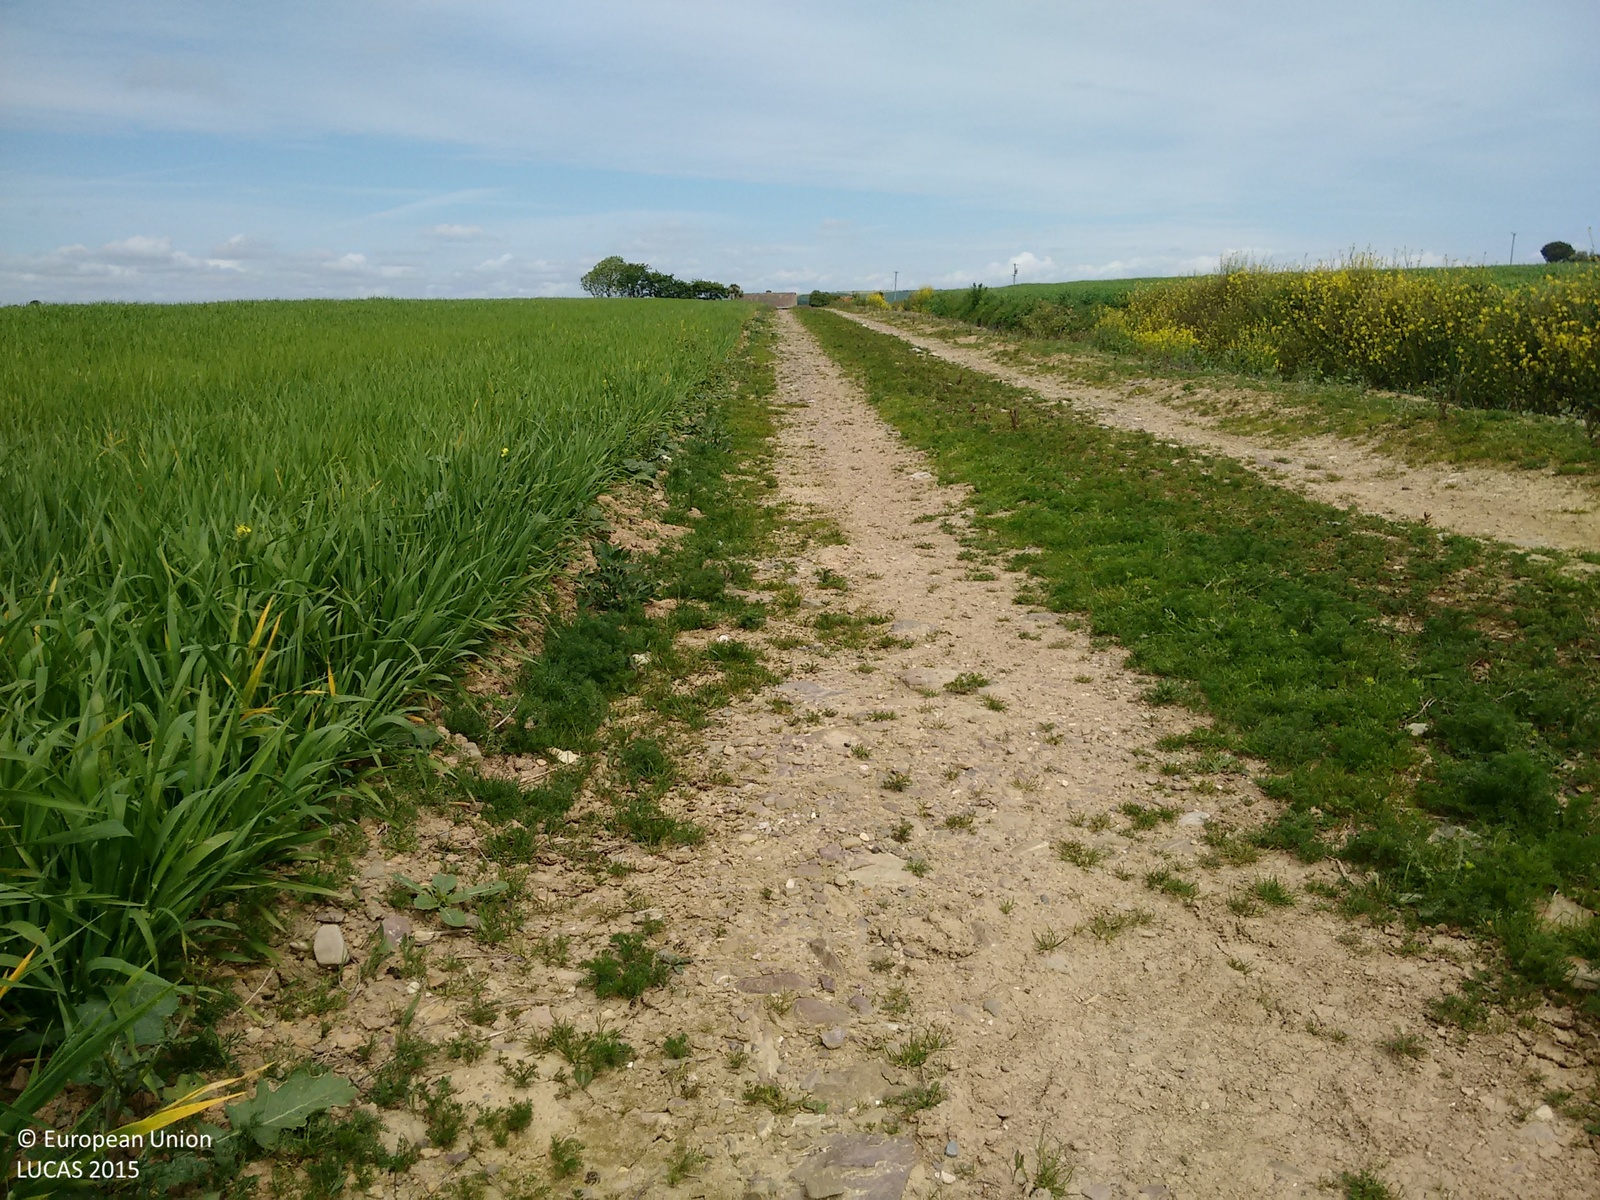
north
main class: Cropland
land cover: Barley
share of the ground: > 75 %
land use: Agriculture (excluding fallow land and kitchen gardens)
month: June
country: IE
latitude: 51.8444
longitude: -8.0462
